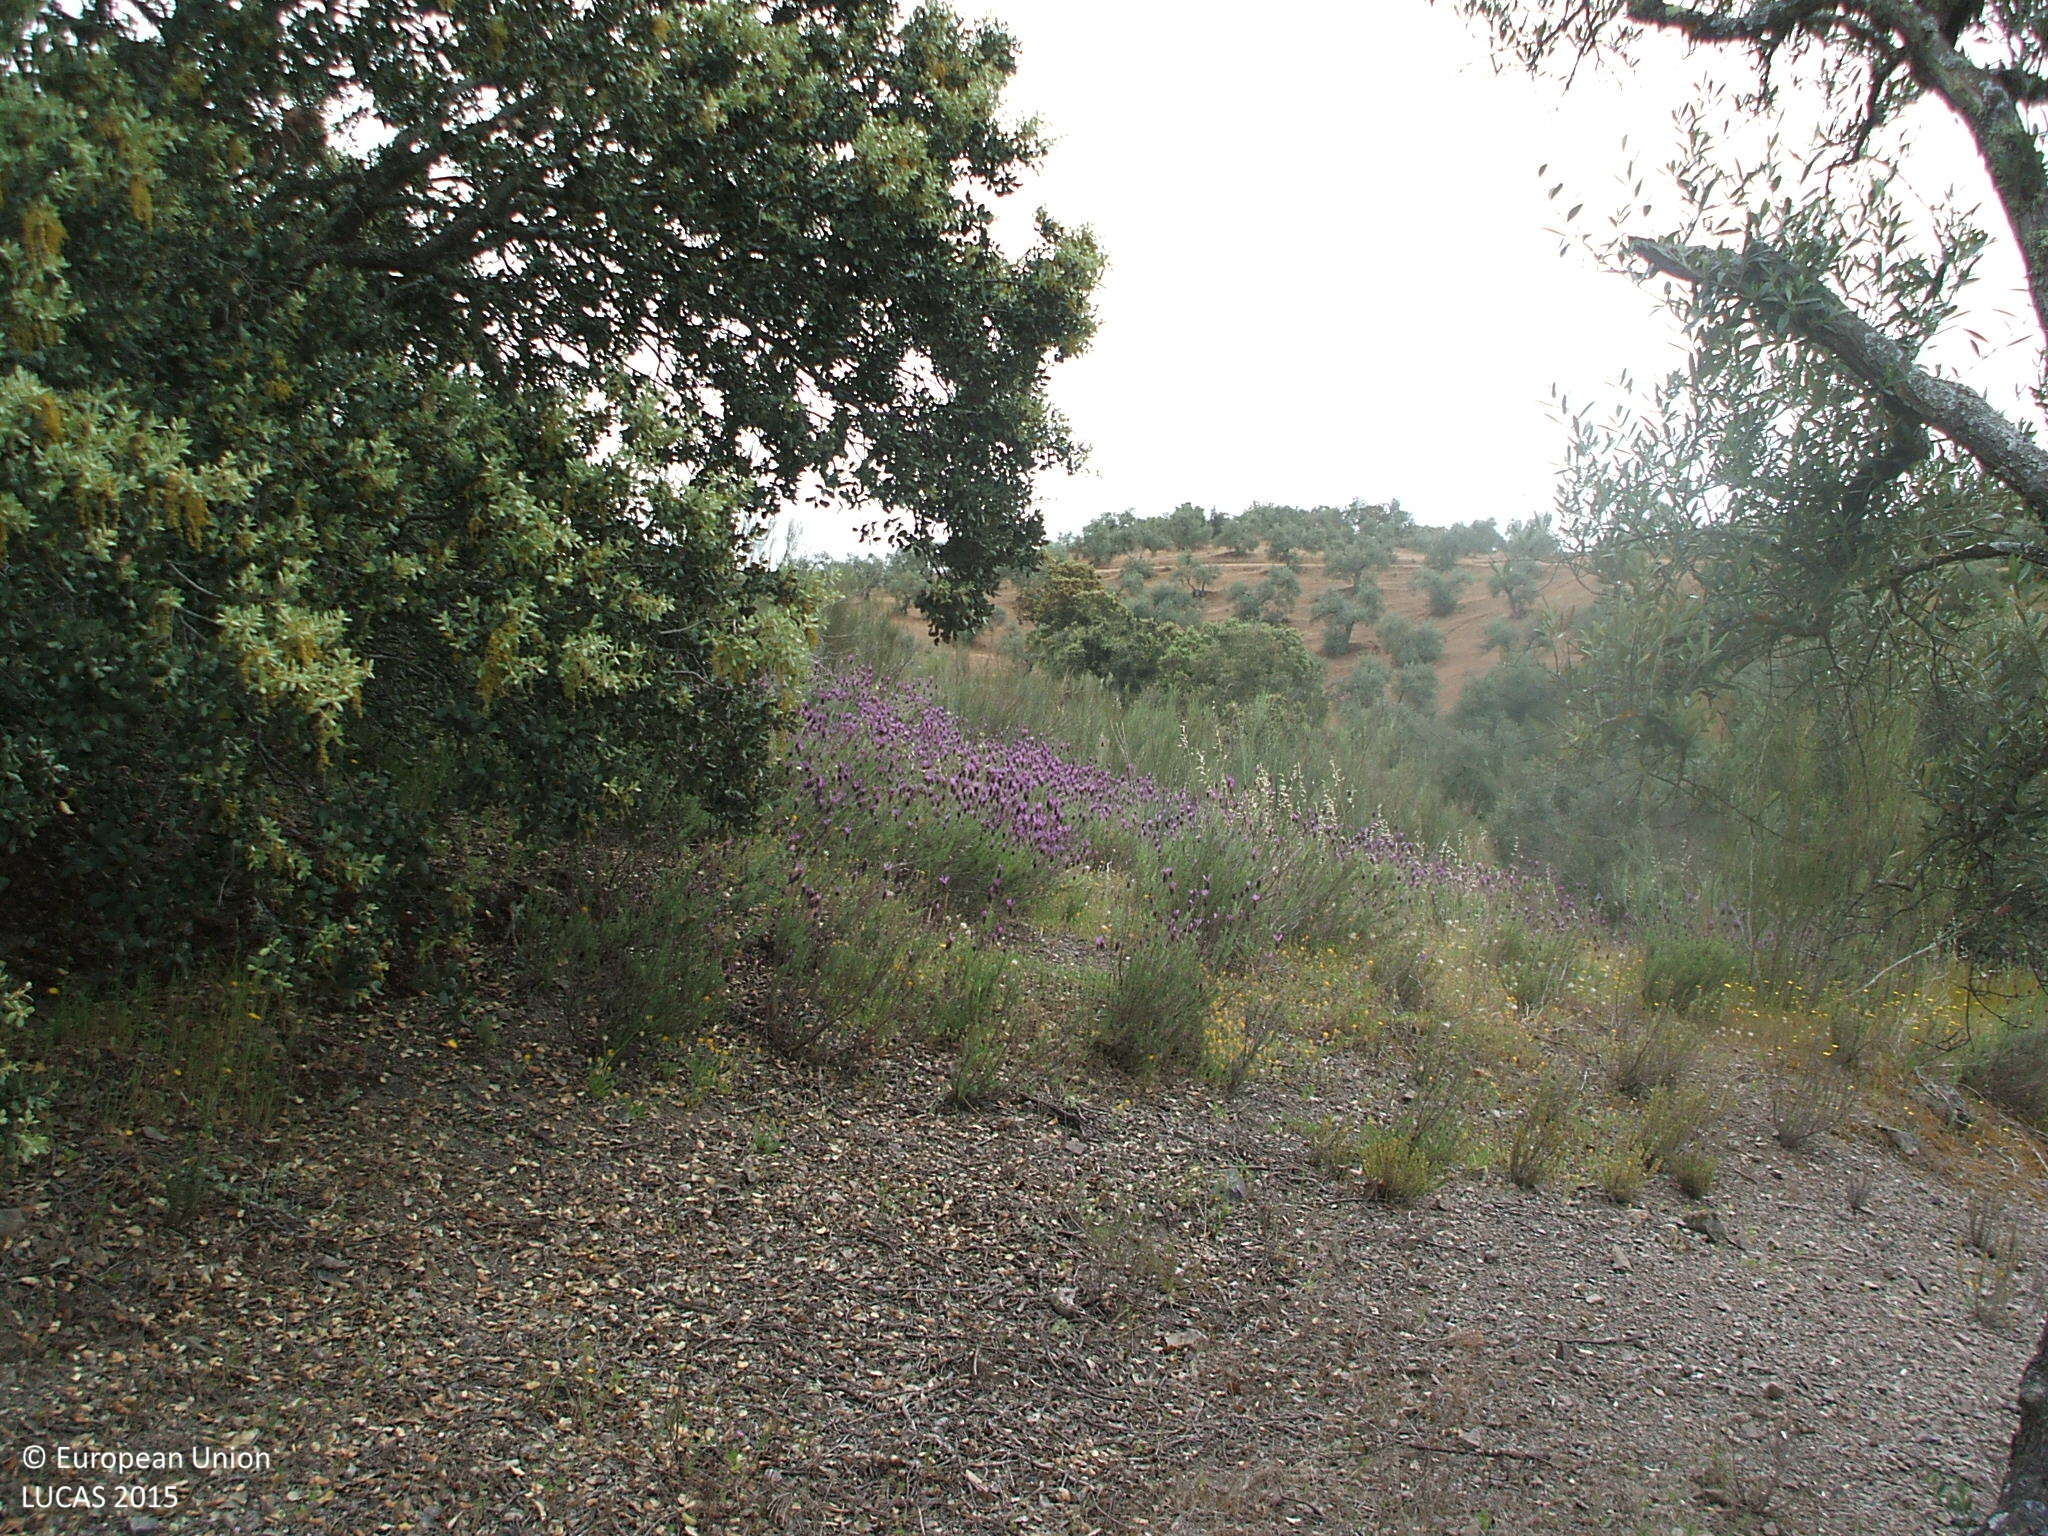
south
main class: Cropland
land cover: Olive groves
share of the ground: 10 - 25 %
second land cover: Shrubland without tree cover
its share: 10 - 25 %
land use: Agriculture (excluding fallow land and kitchen gardens)
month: April
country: ES
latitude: 38.1265
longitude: -5.7181
